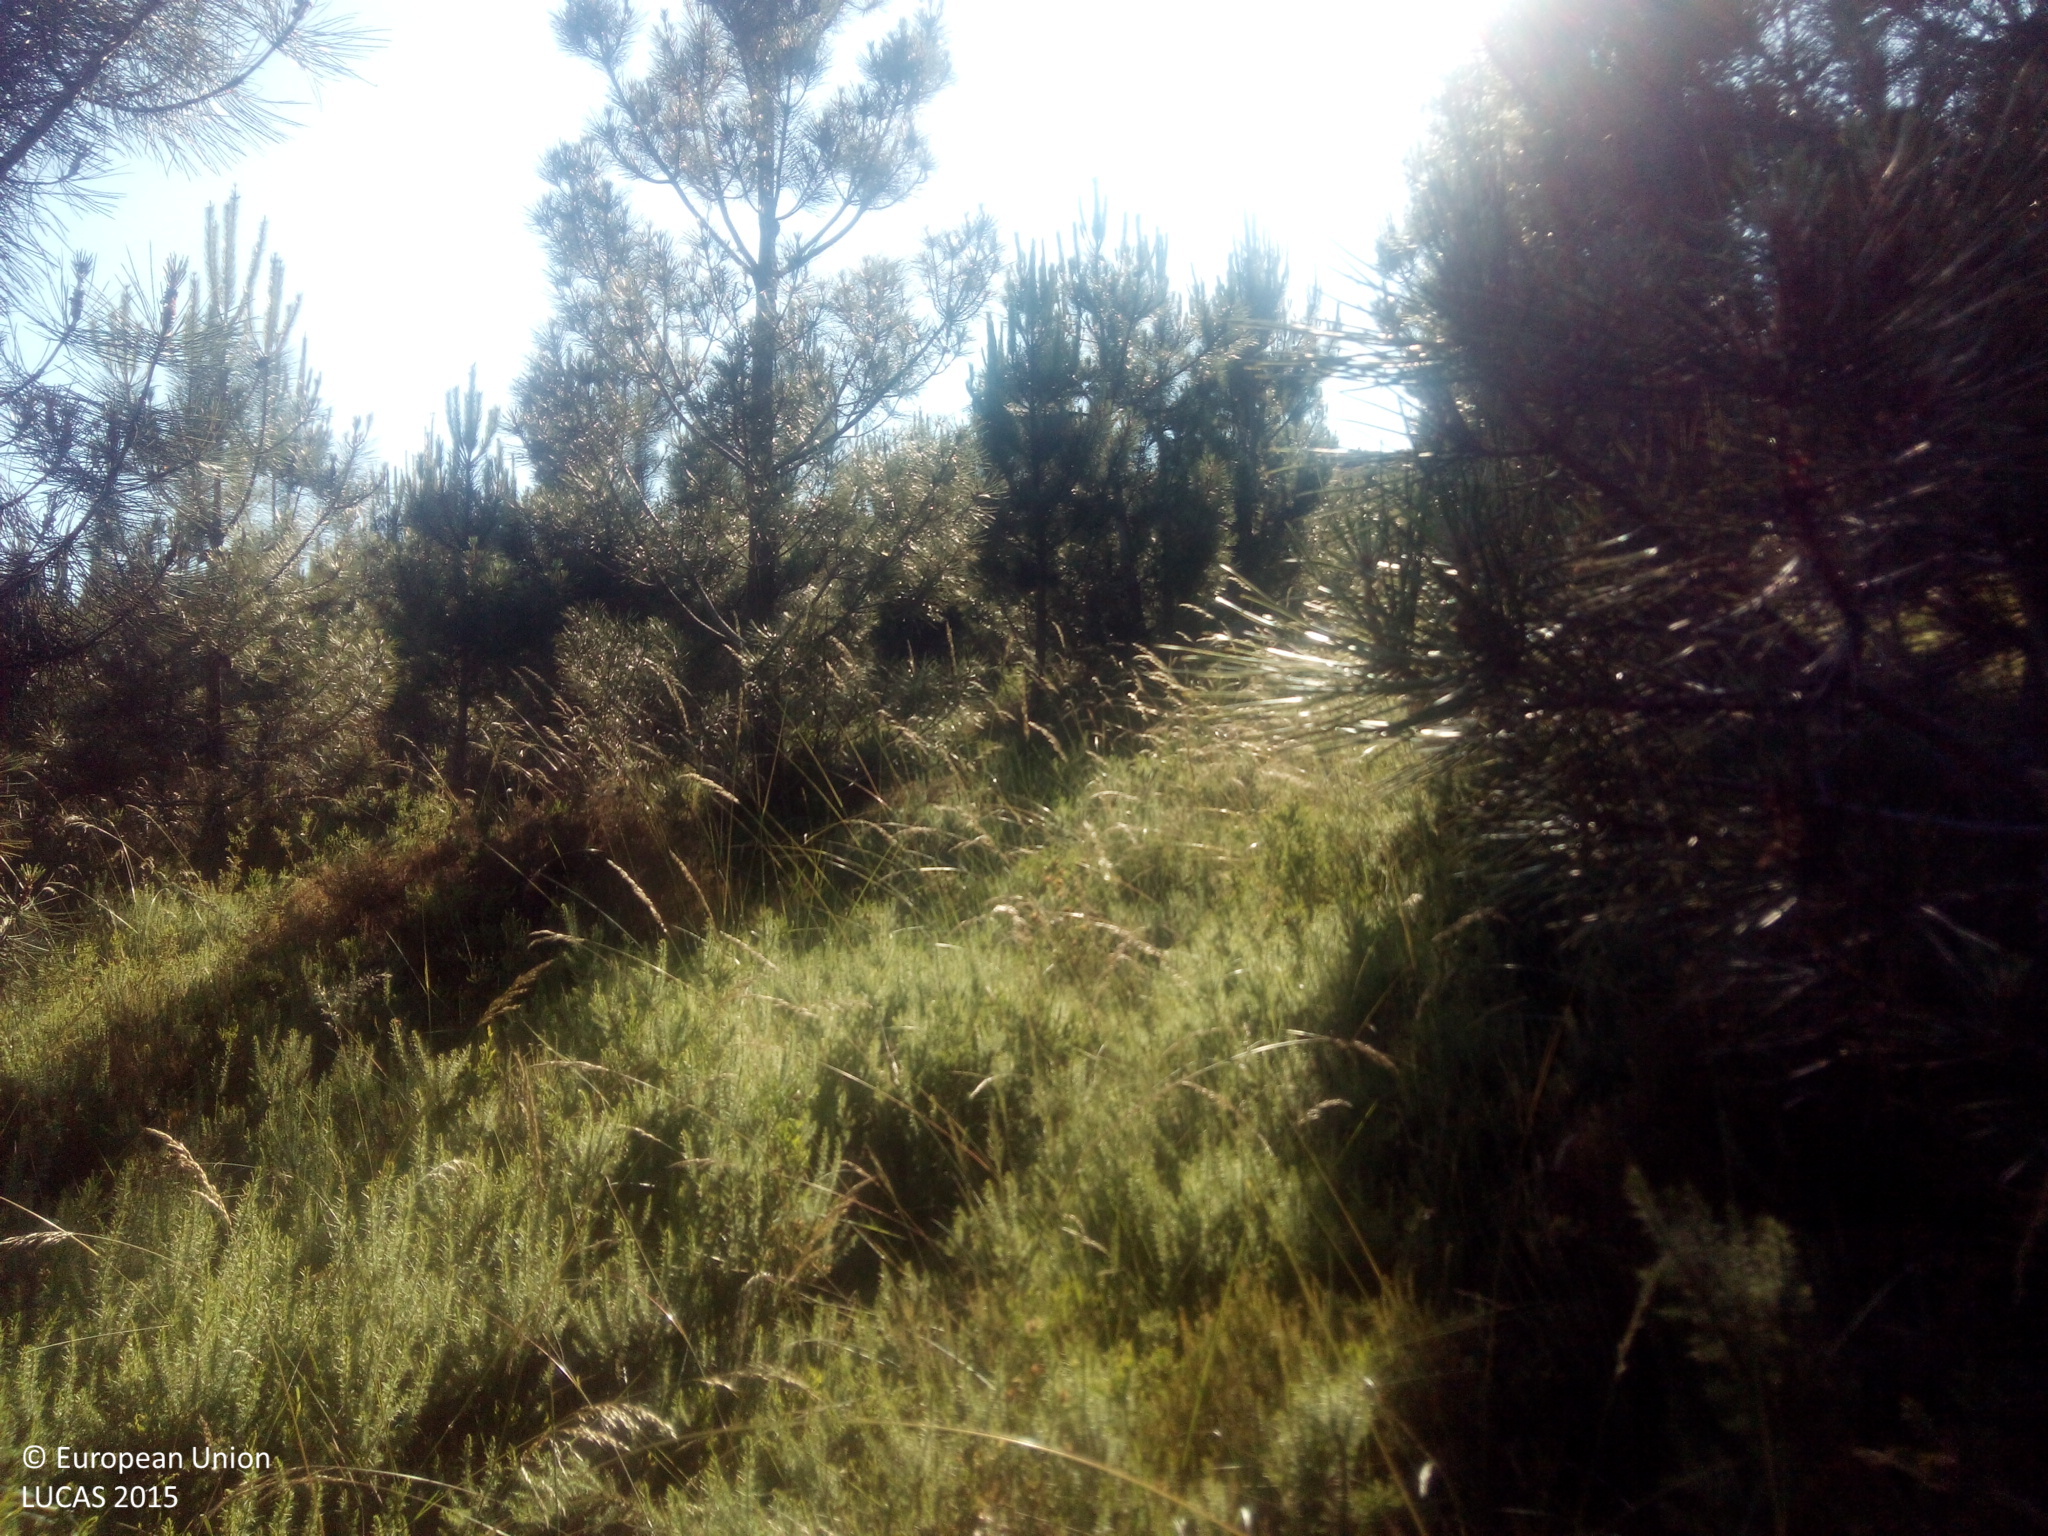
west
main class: Woodland
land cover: Pine dominated coniferous woodland
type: hemiboreal forest and nemoral coniferous forest and mixed broadleaved-coniferous forest
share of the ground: > 75 %
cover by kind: coniferous forest trees 100 %
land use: Forestry
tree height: < 5 m
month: June
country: ES
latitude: 42.4444
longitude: -8.3163
